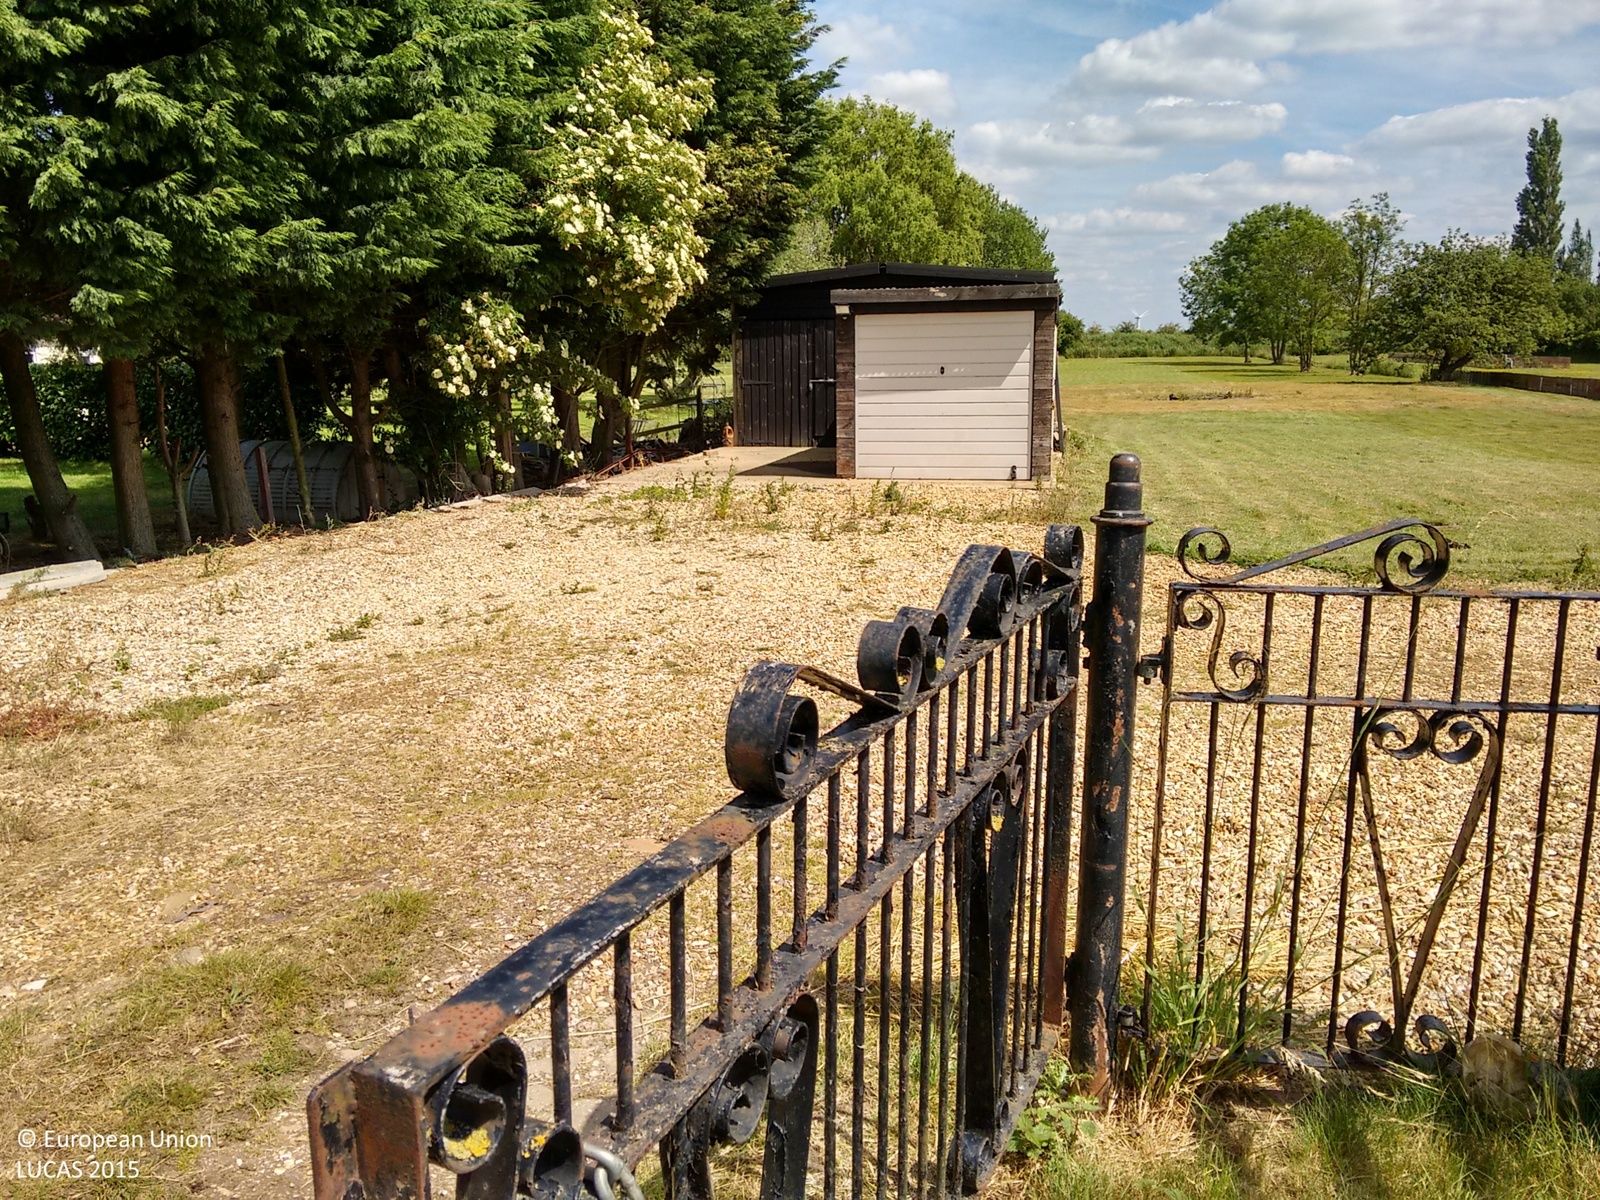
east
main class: Grassland
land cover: Grassland without tree/shrub cover
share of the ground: > 75 %
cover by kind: herbaceous plants 100 %
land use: Residential
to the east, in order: Grassland without tree/shrub cover; Artificial constructions in urban areas; Shrubland with sparse tree cover; Railways; Shrubland with sparse tree cover; Rape and turnip rape
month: June
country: GB
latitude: 52.5783
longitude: 0.0960
